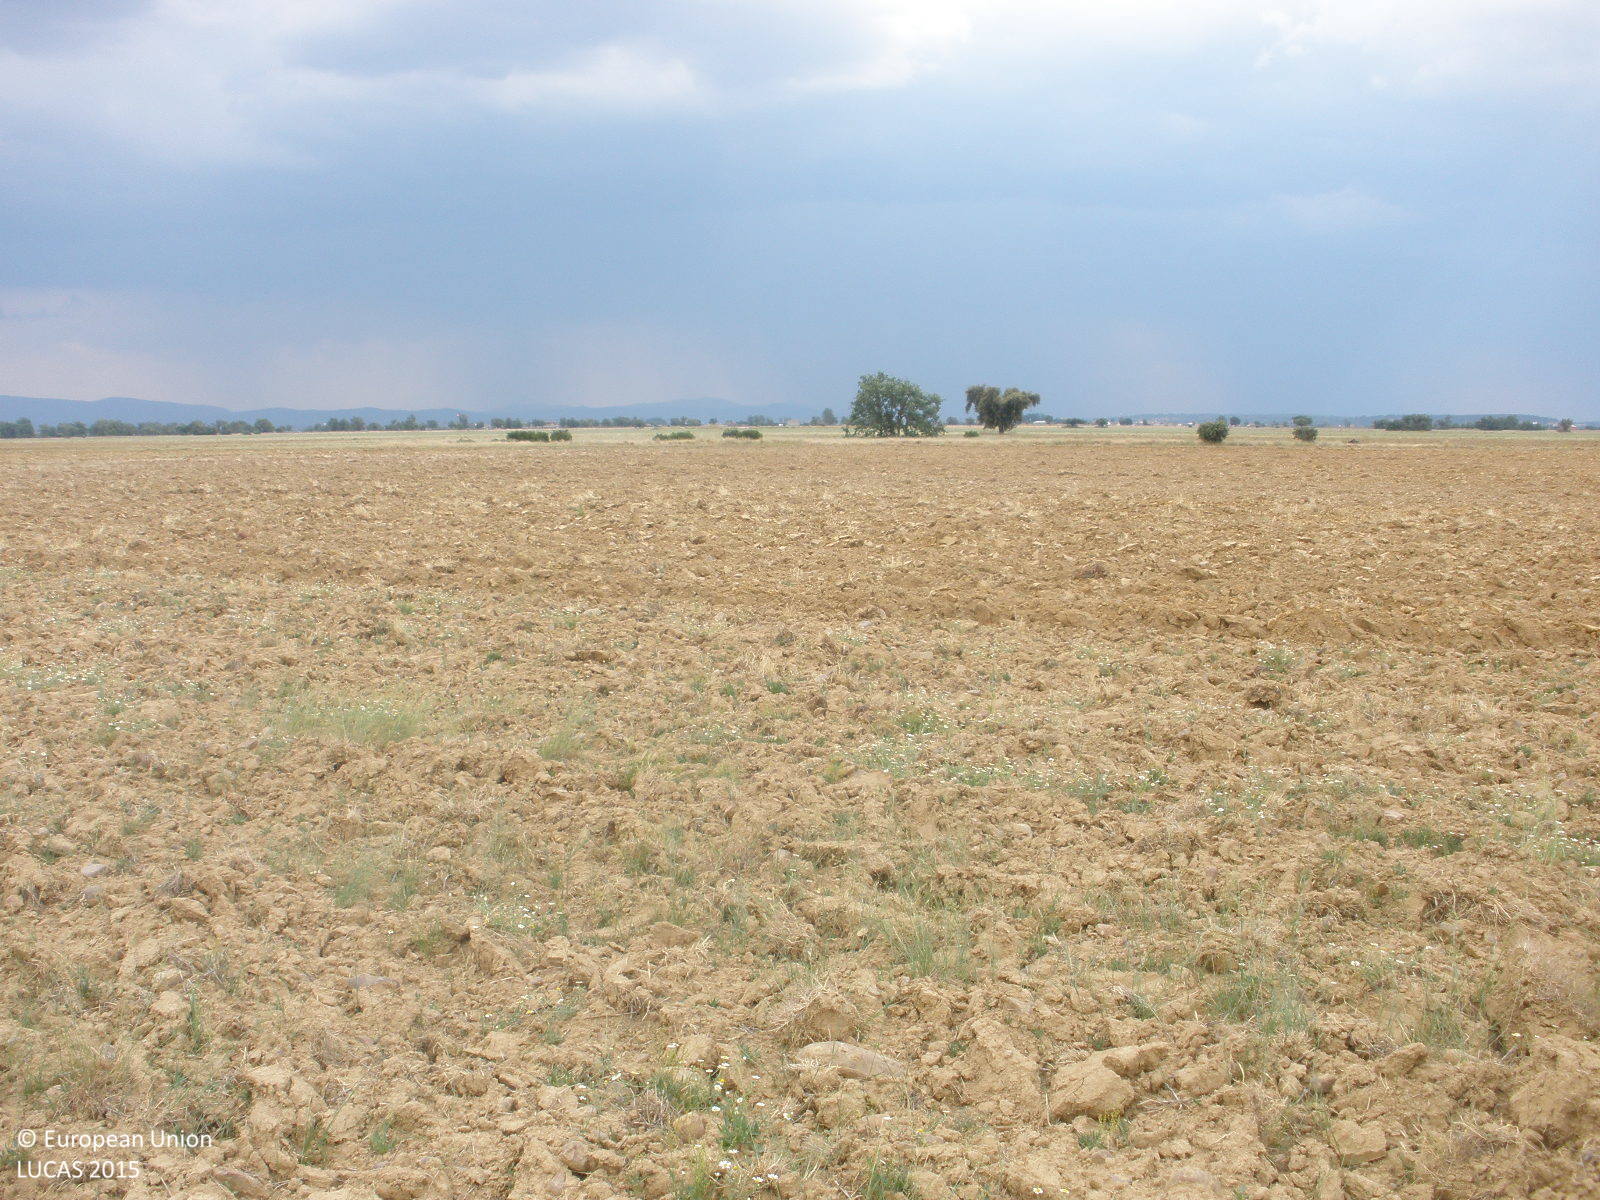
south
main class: Grassland
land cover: Spontaneously vegetated surfaces
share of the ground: 25 - 50 %
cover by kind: unconsolidated bare surface 60 %, herbaceous plants 40 %
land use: Fallow land
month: June
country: ES
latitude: 40.7371
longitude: -6.3948
